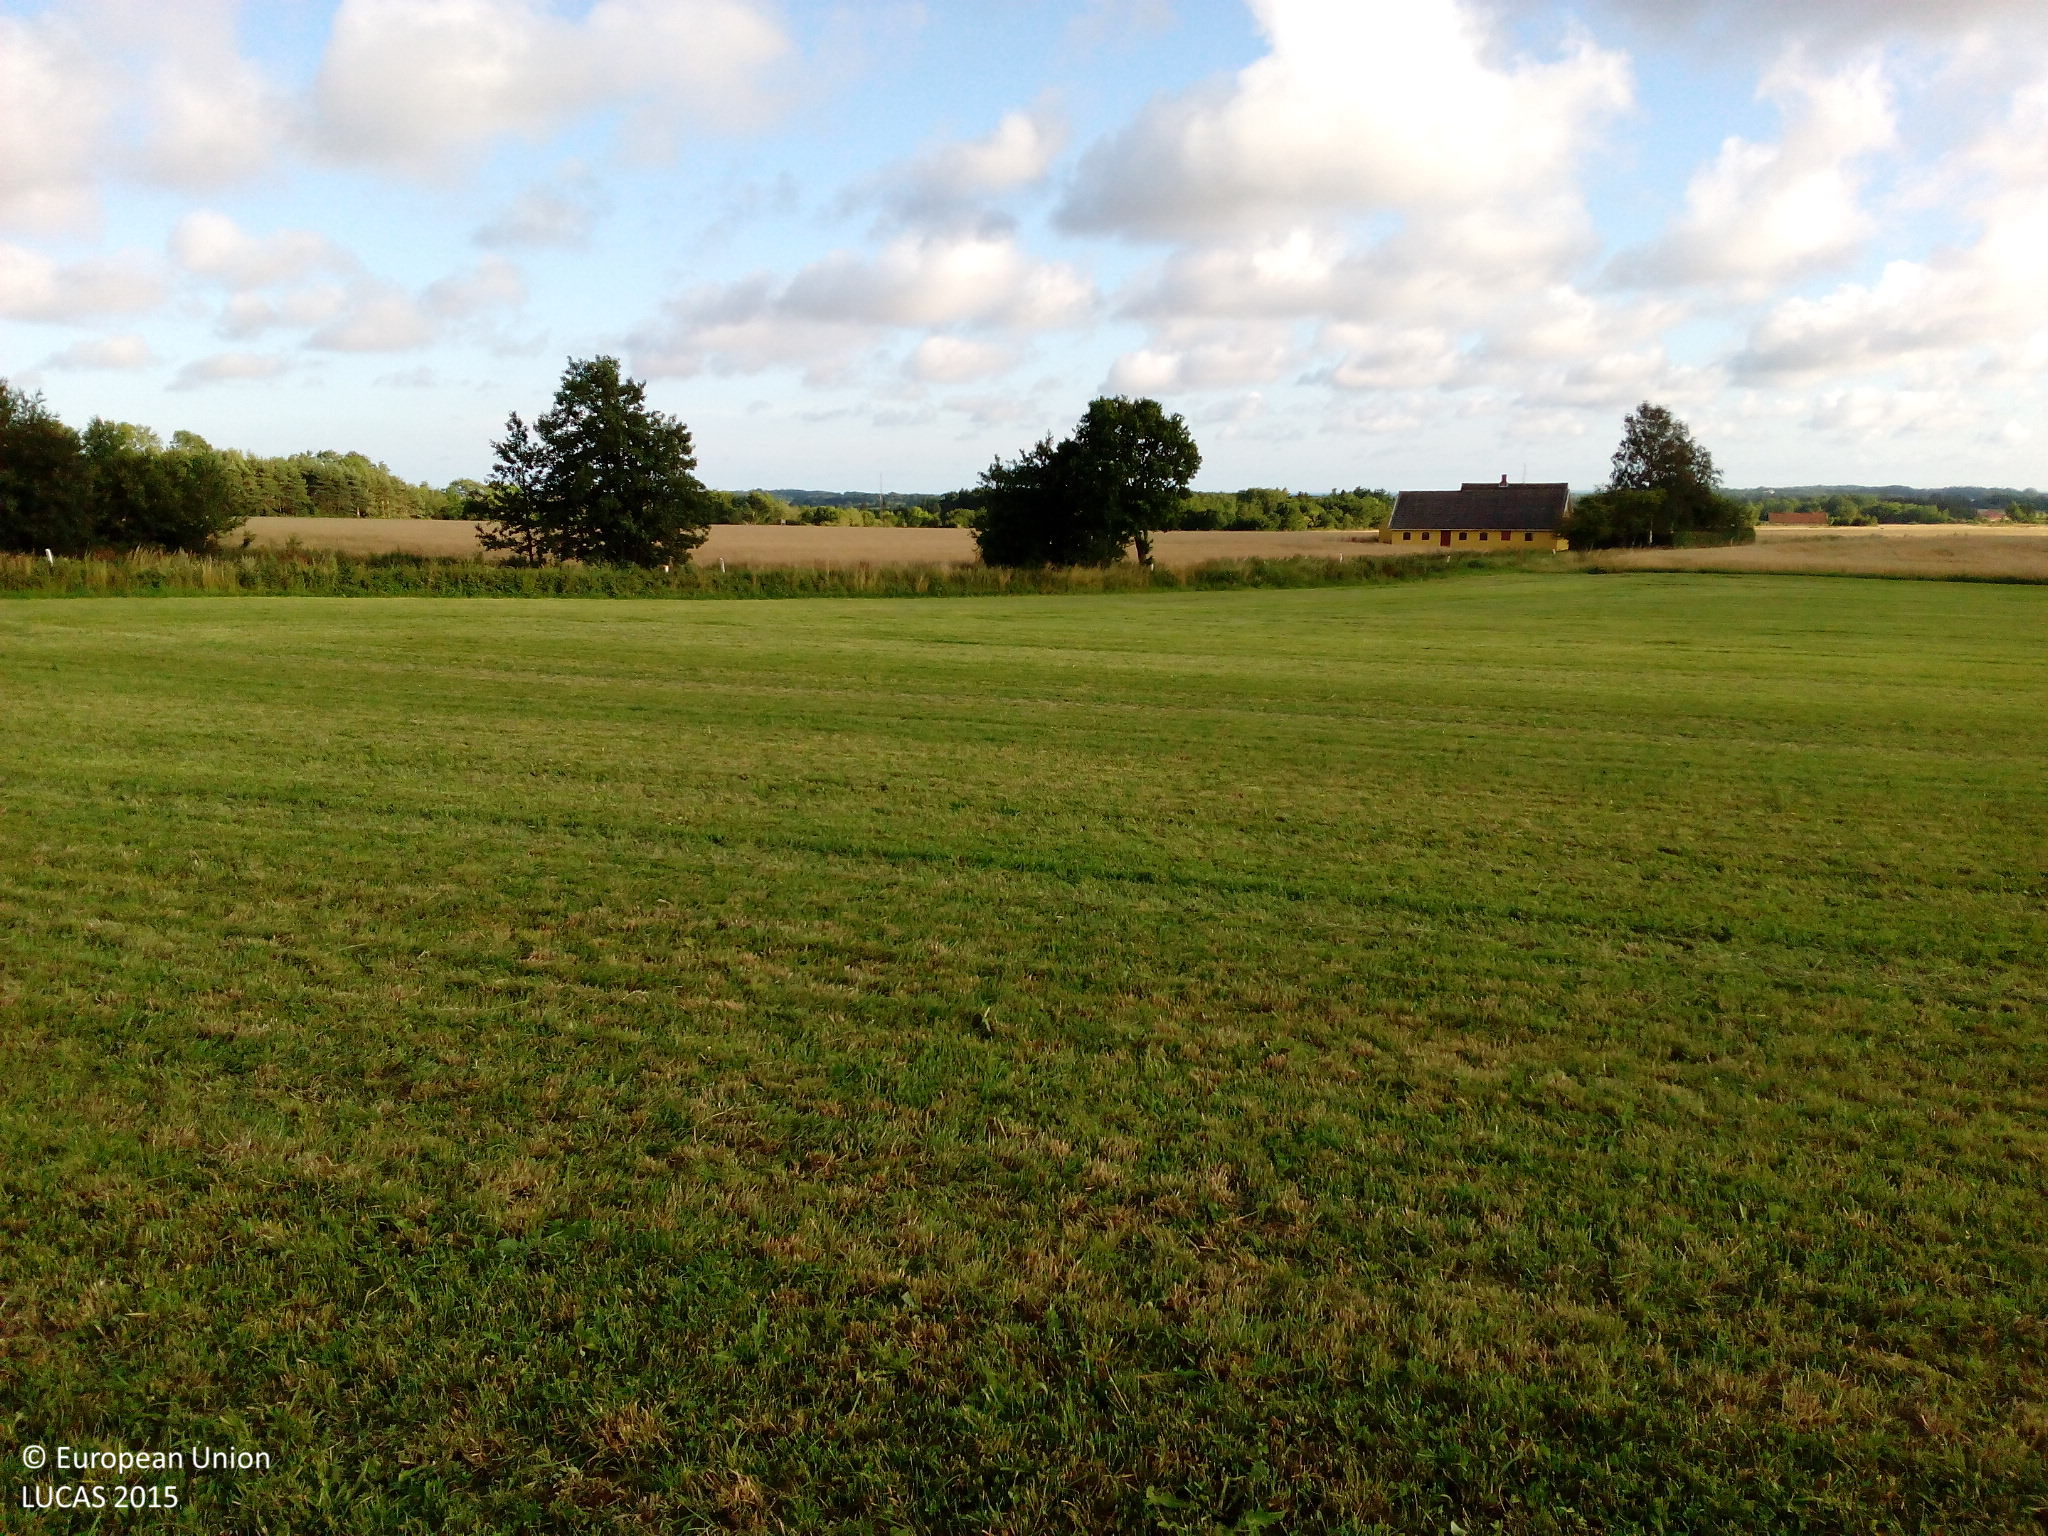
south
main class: Grassland
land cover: Grassland without tree/shrub cover
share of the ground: > 75 %
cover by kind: herbaceous plants 100 %
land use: Agriculture (excluding fallow land and kitchen gardens)
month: August
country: DK
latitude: 55.0639
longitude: 14.9953
